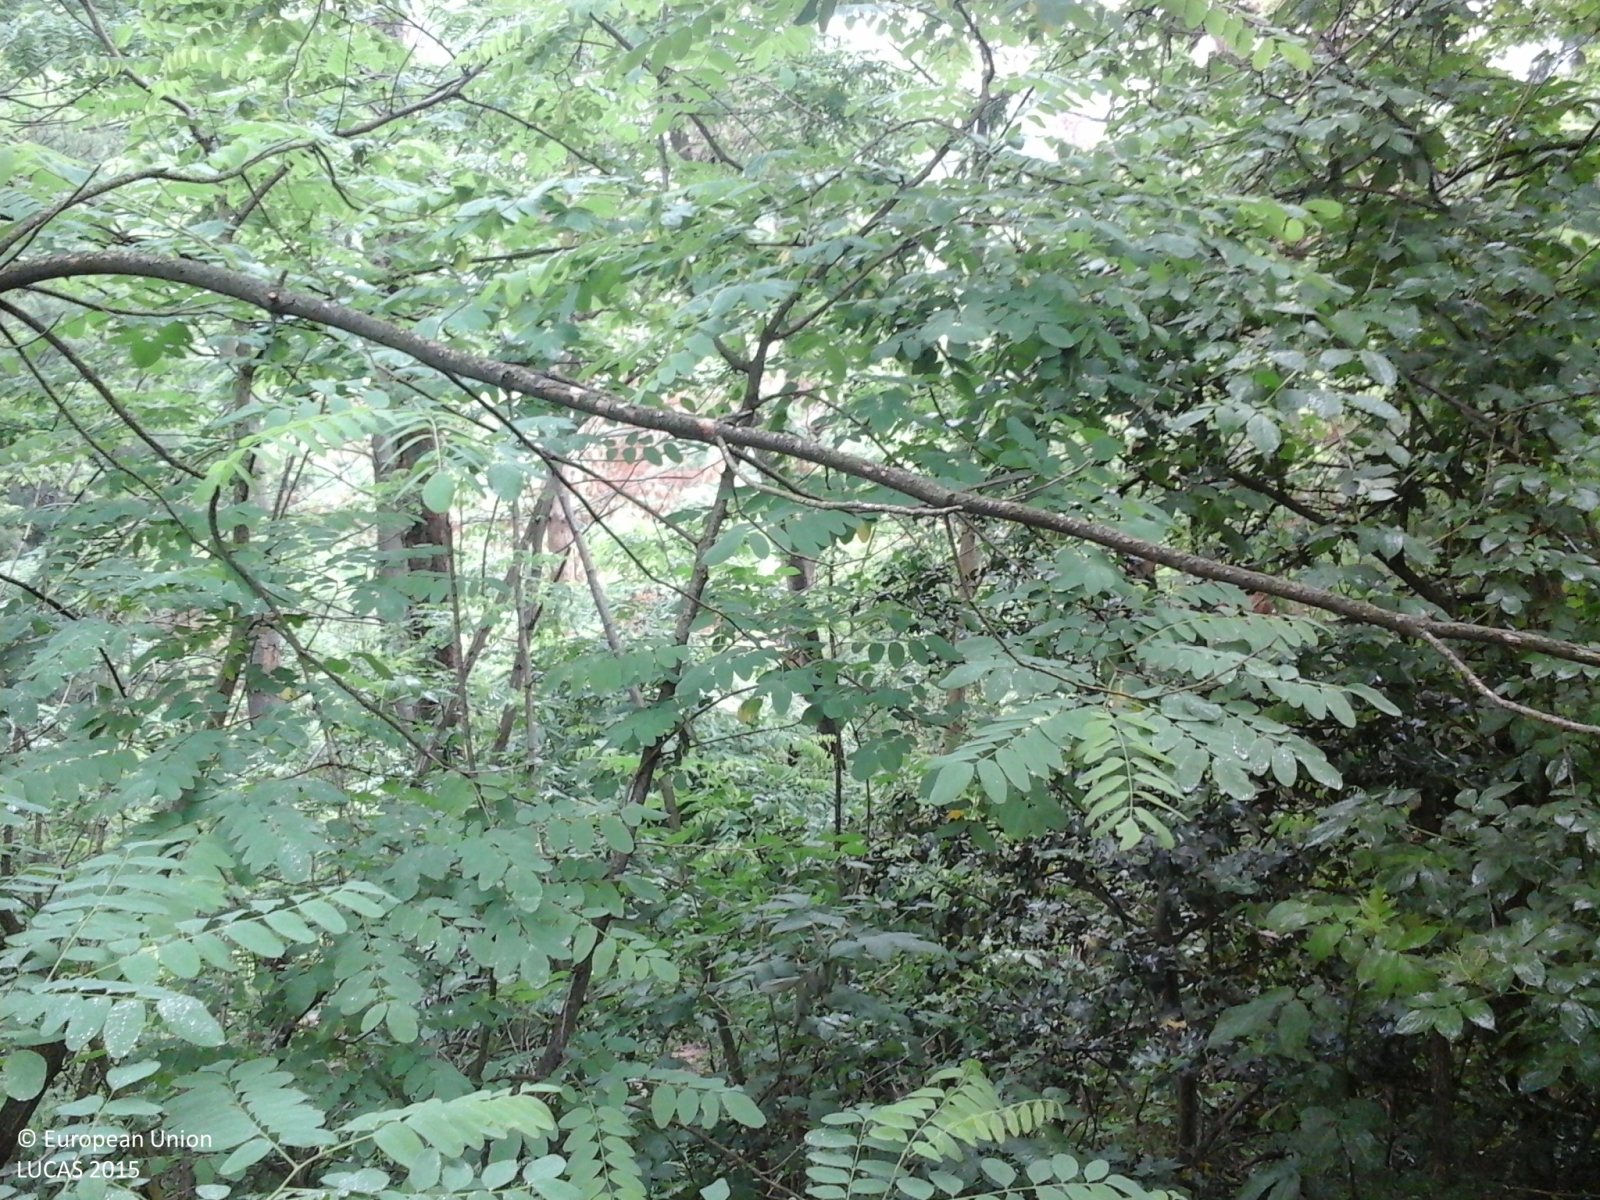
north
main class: Woodland
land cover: Broadleaved woodland
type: thermophilous deciduous forest
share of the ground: > 75 %
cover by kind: broadleaved forest trees 100 %
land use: Forestry
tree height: > 5 m
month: May
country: IT
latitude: 45.5976
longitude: 8.2208
